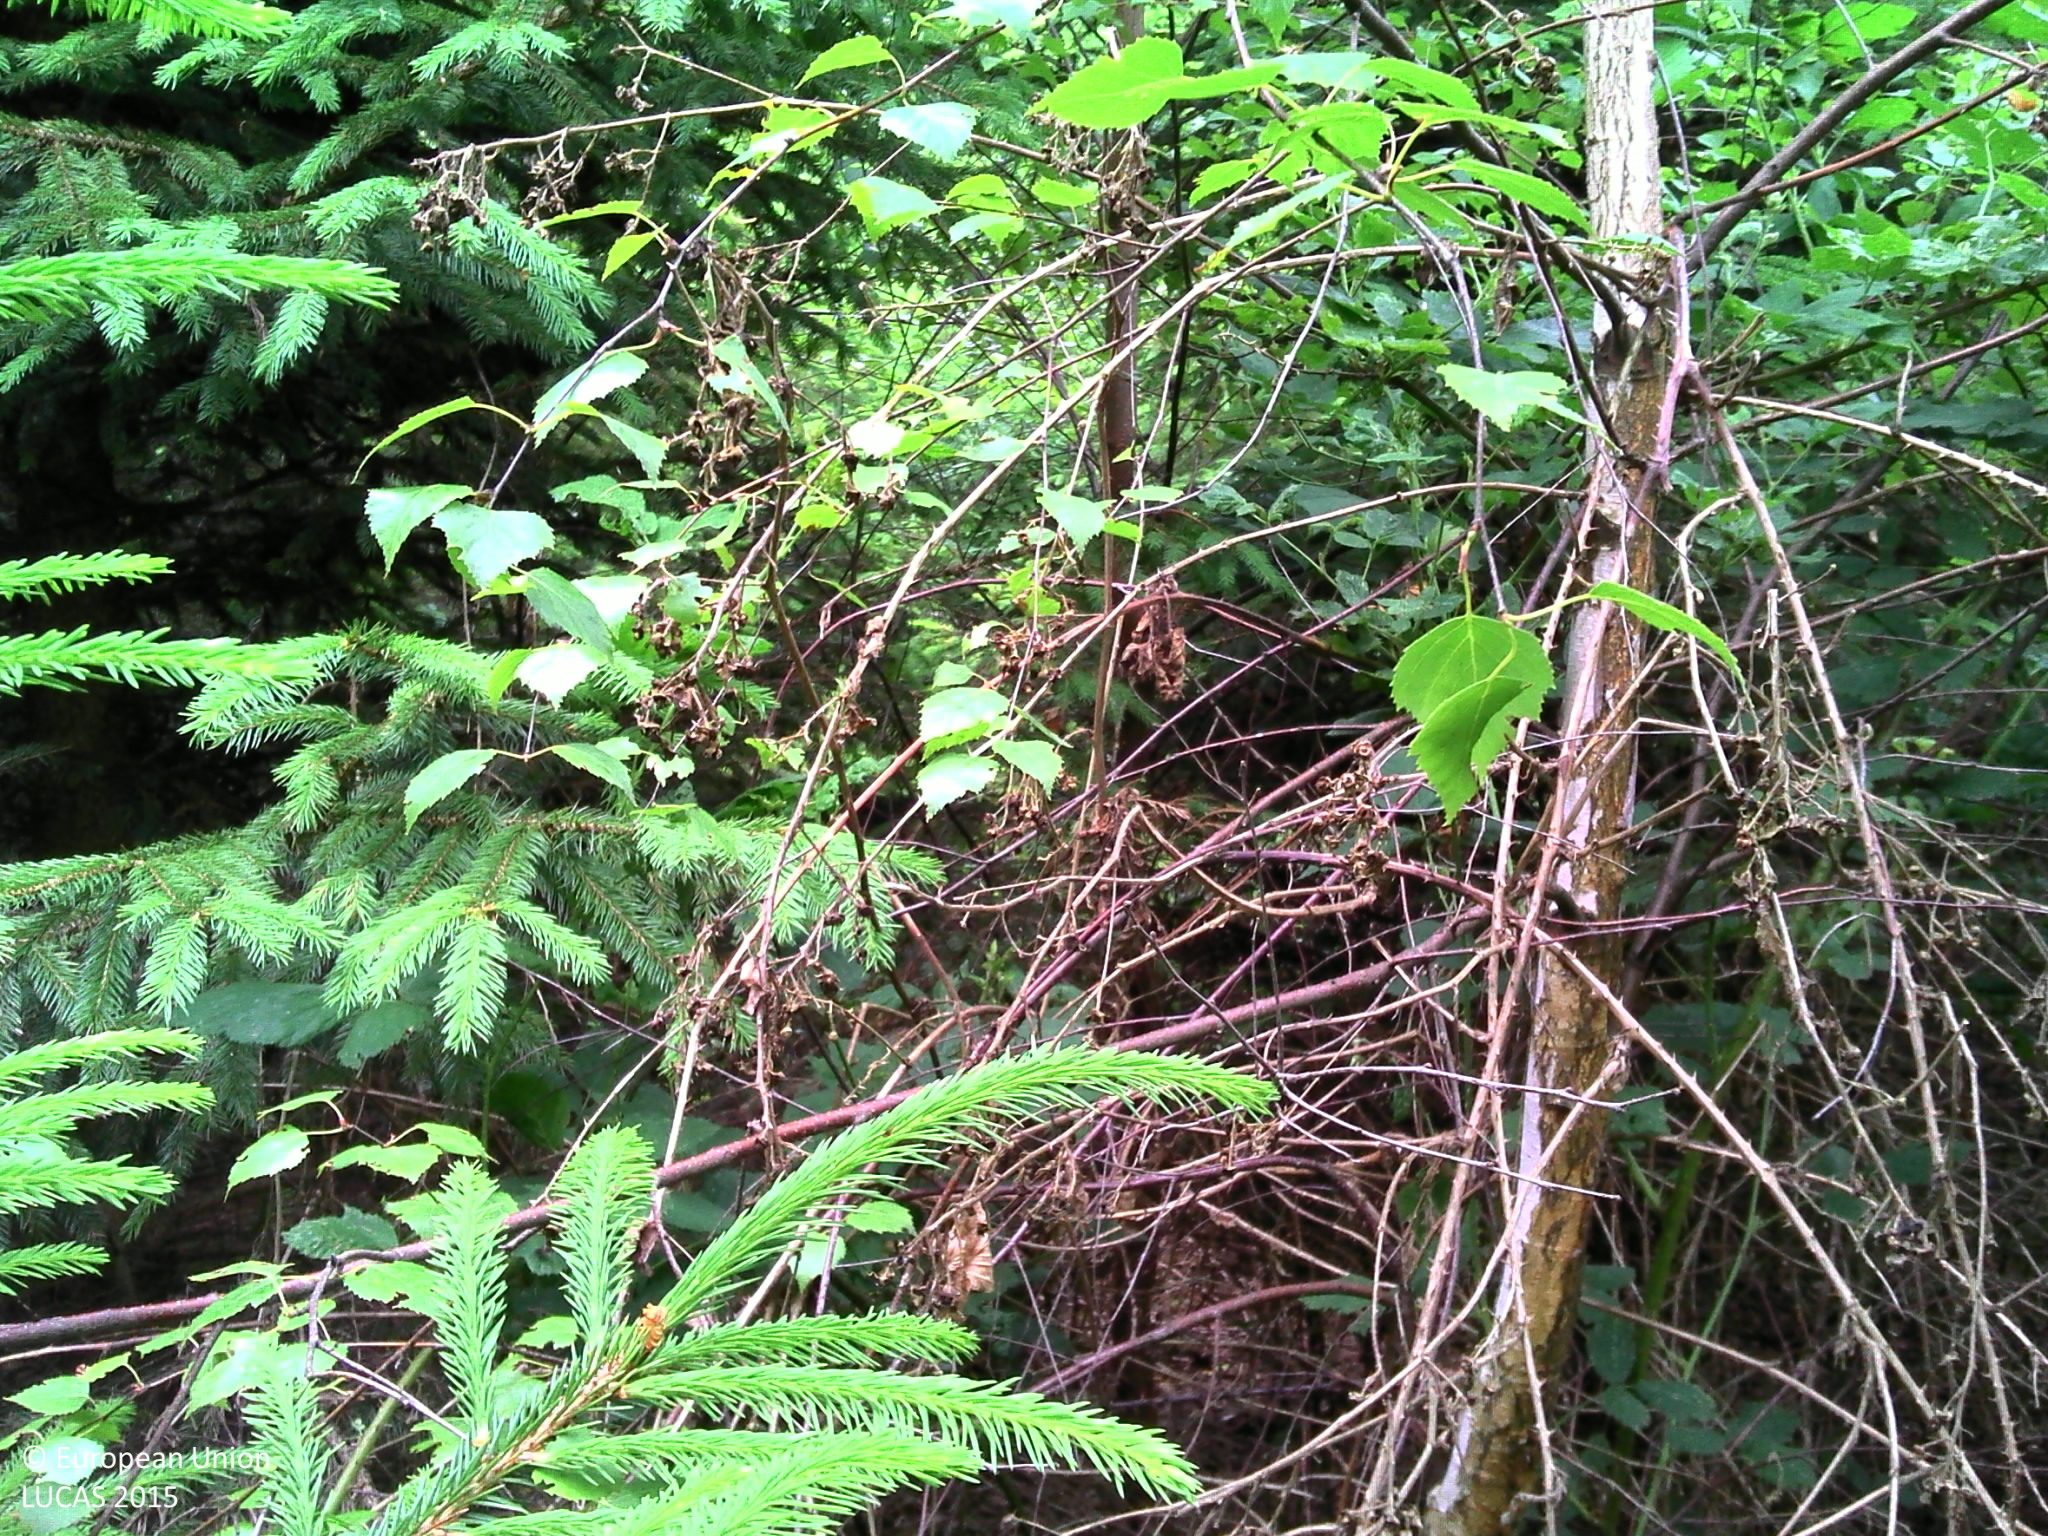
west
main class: Woodland
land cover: Spruce dominated coniferous woodland
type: alpine coniferous forest
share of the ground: > 75 %
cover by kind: coniferous forest trees 100 %
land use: Forestry
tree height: > 5 m
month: June
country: BE
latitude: 49.8739
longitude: 5.3645
